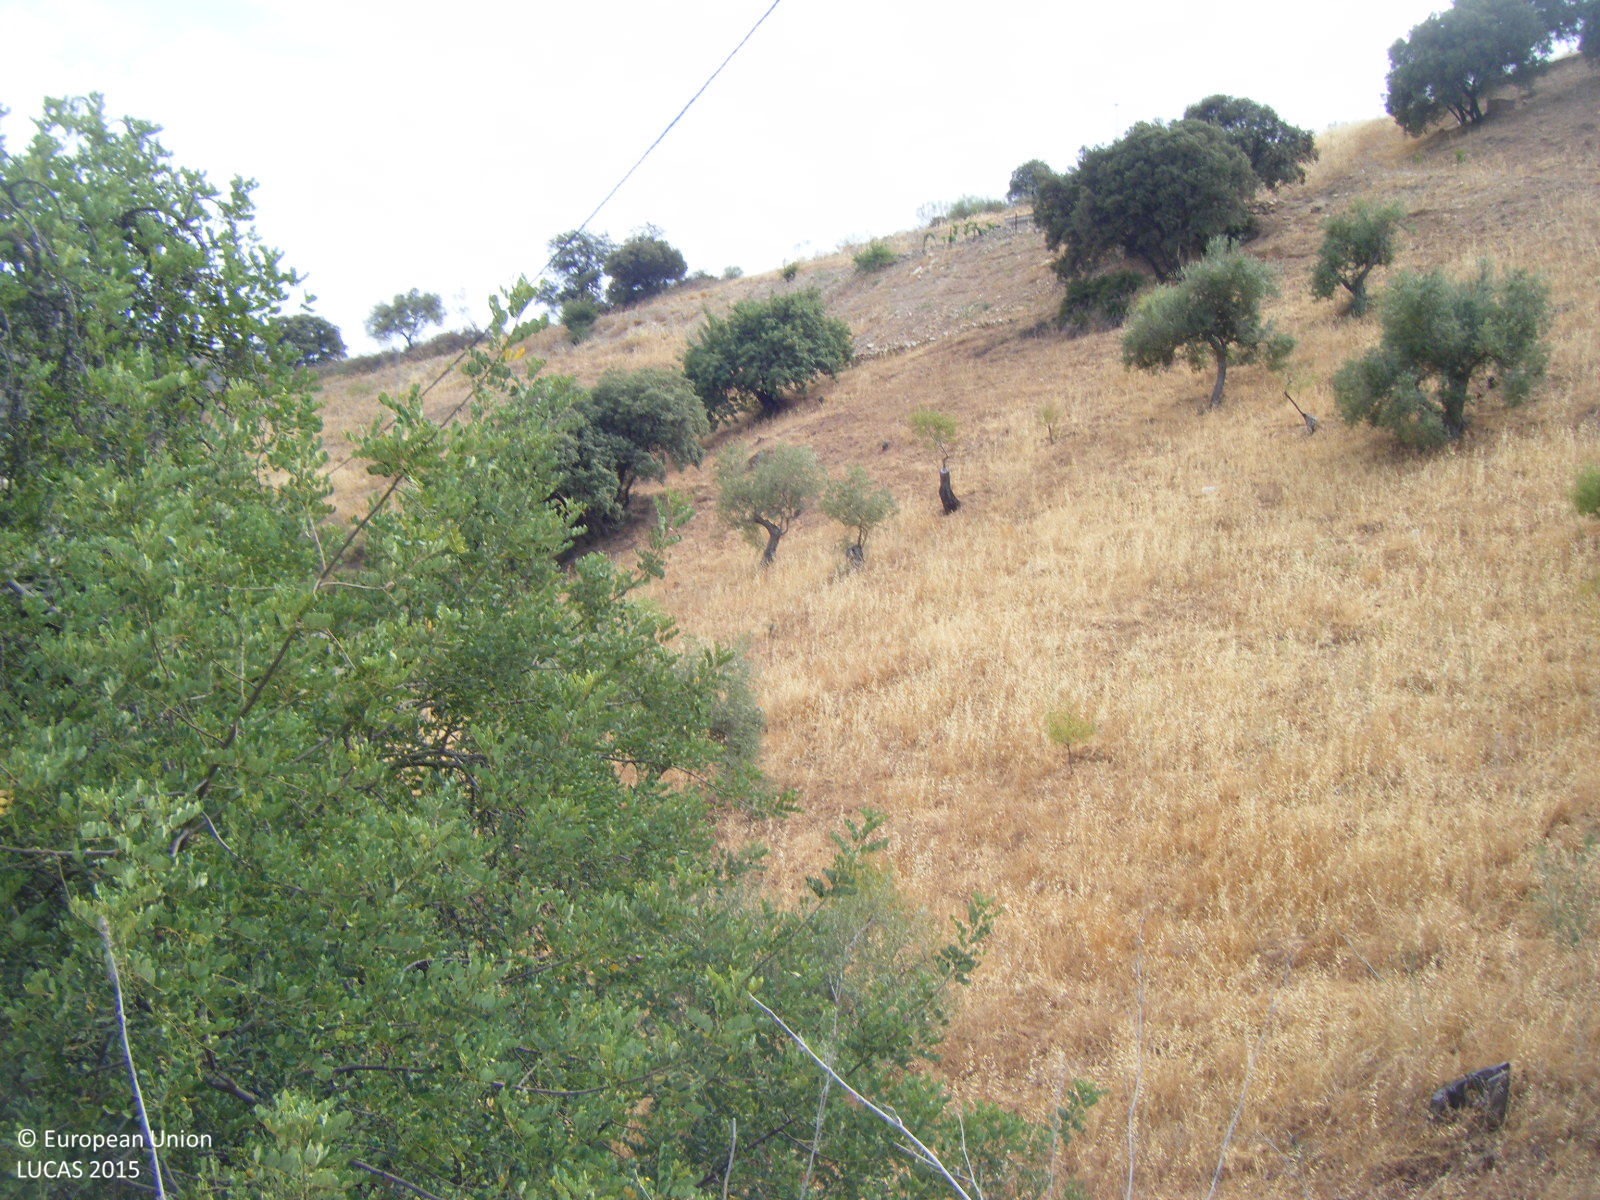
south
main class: Shrubland
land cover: Shrubland without tree cover
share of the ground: > 75 %
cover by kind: shrubs 100 %
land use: Semi-natural and natural areas not in use
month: July
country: ES
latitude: 36.8582
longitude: -4.4503
